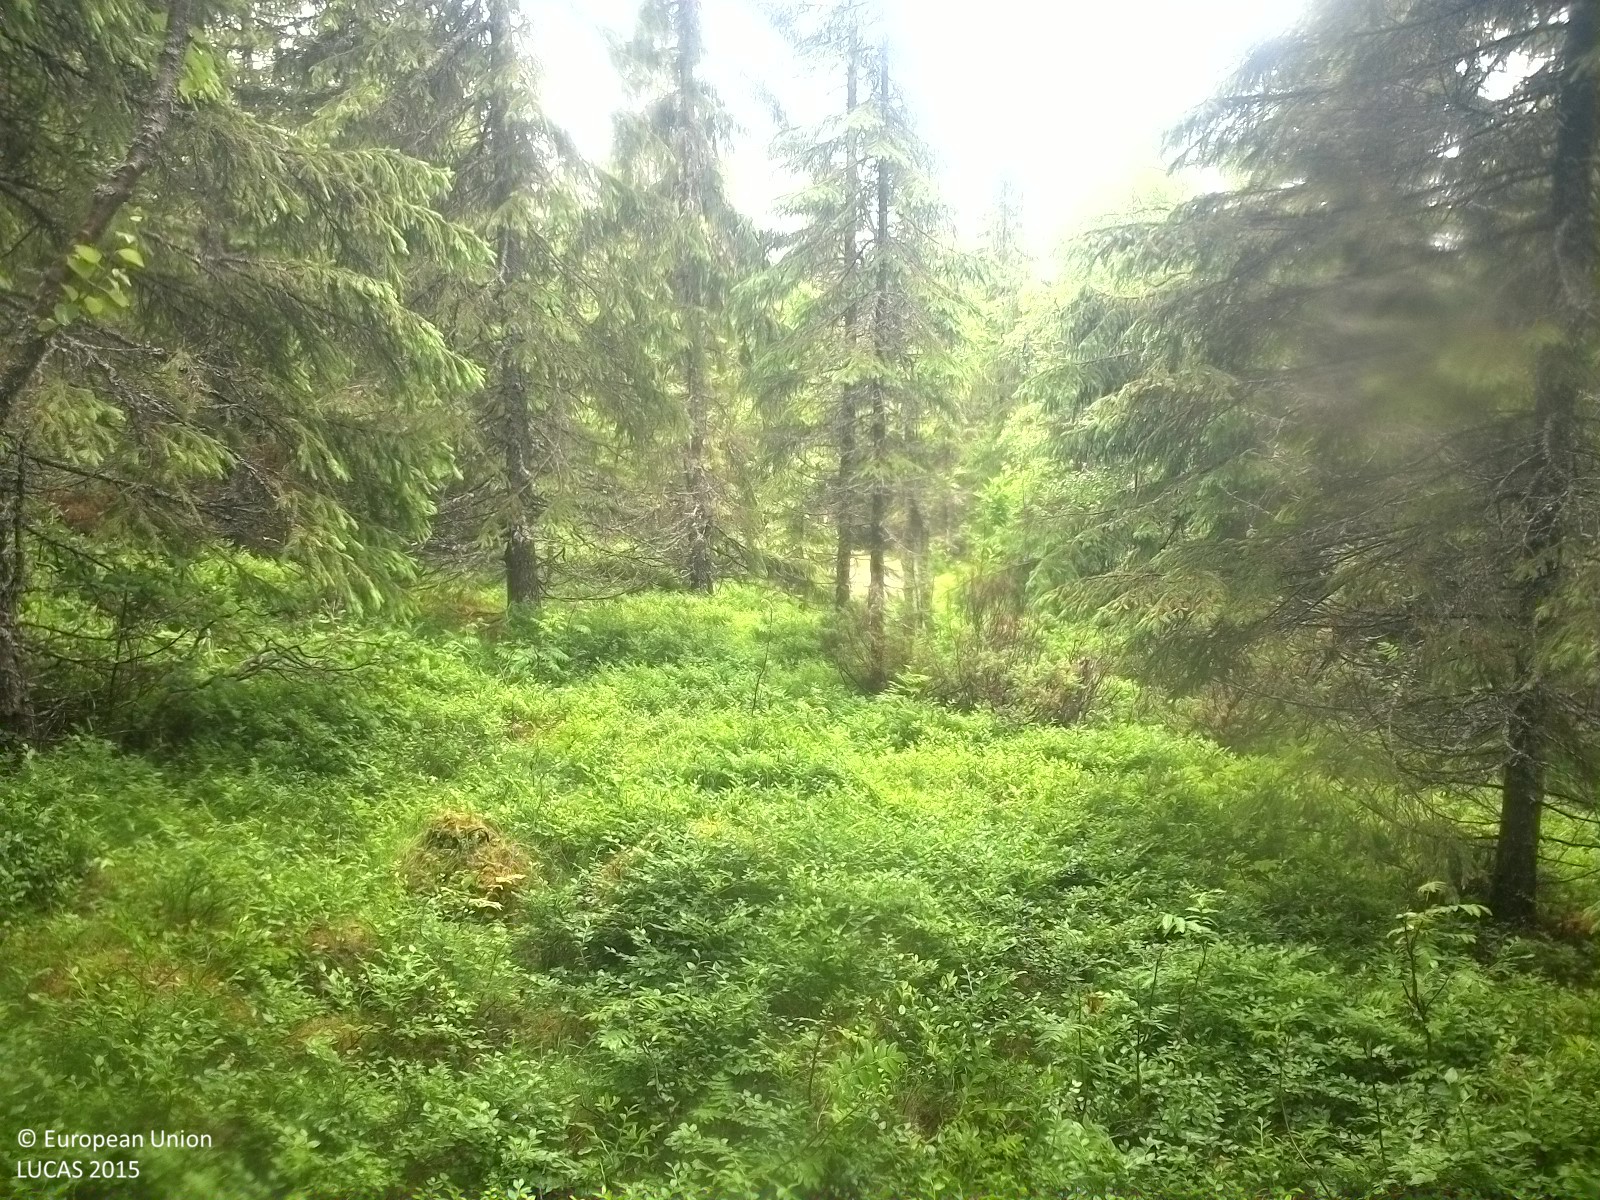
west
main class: Woodland
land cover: Spruce dominated mixed woodland
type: boreal forest
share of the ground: 25 - 50 %
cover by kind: shrubs 50 %, coniferous forest trees 35 %, broadleaved forest trees 15 %
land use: Forestry
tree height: > 5 m
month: July
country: SE
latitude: 62.4721
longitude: 16.9033
